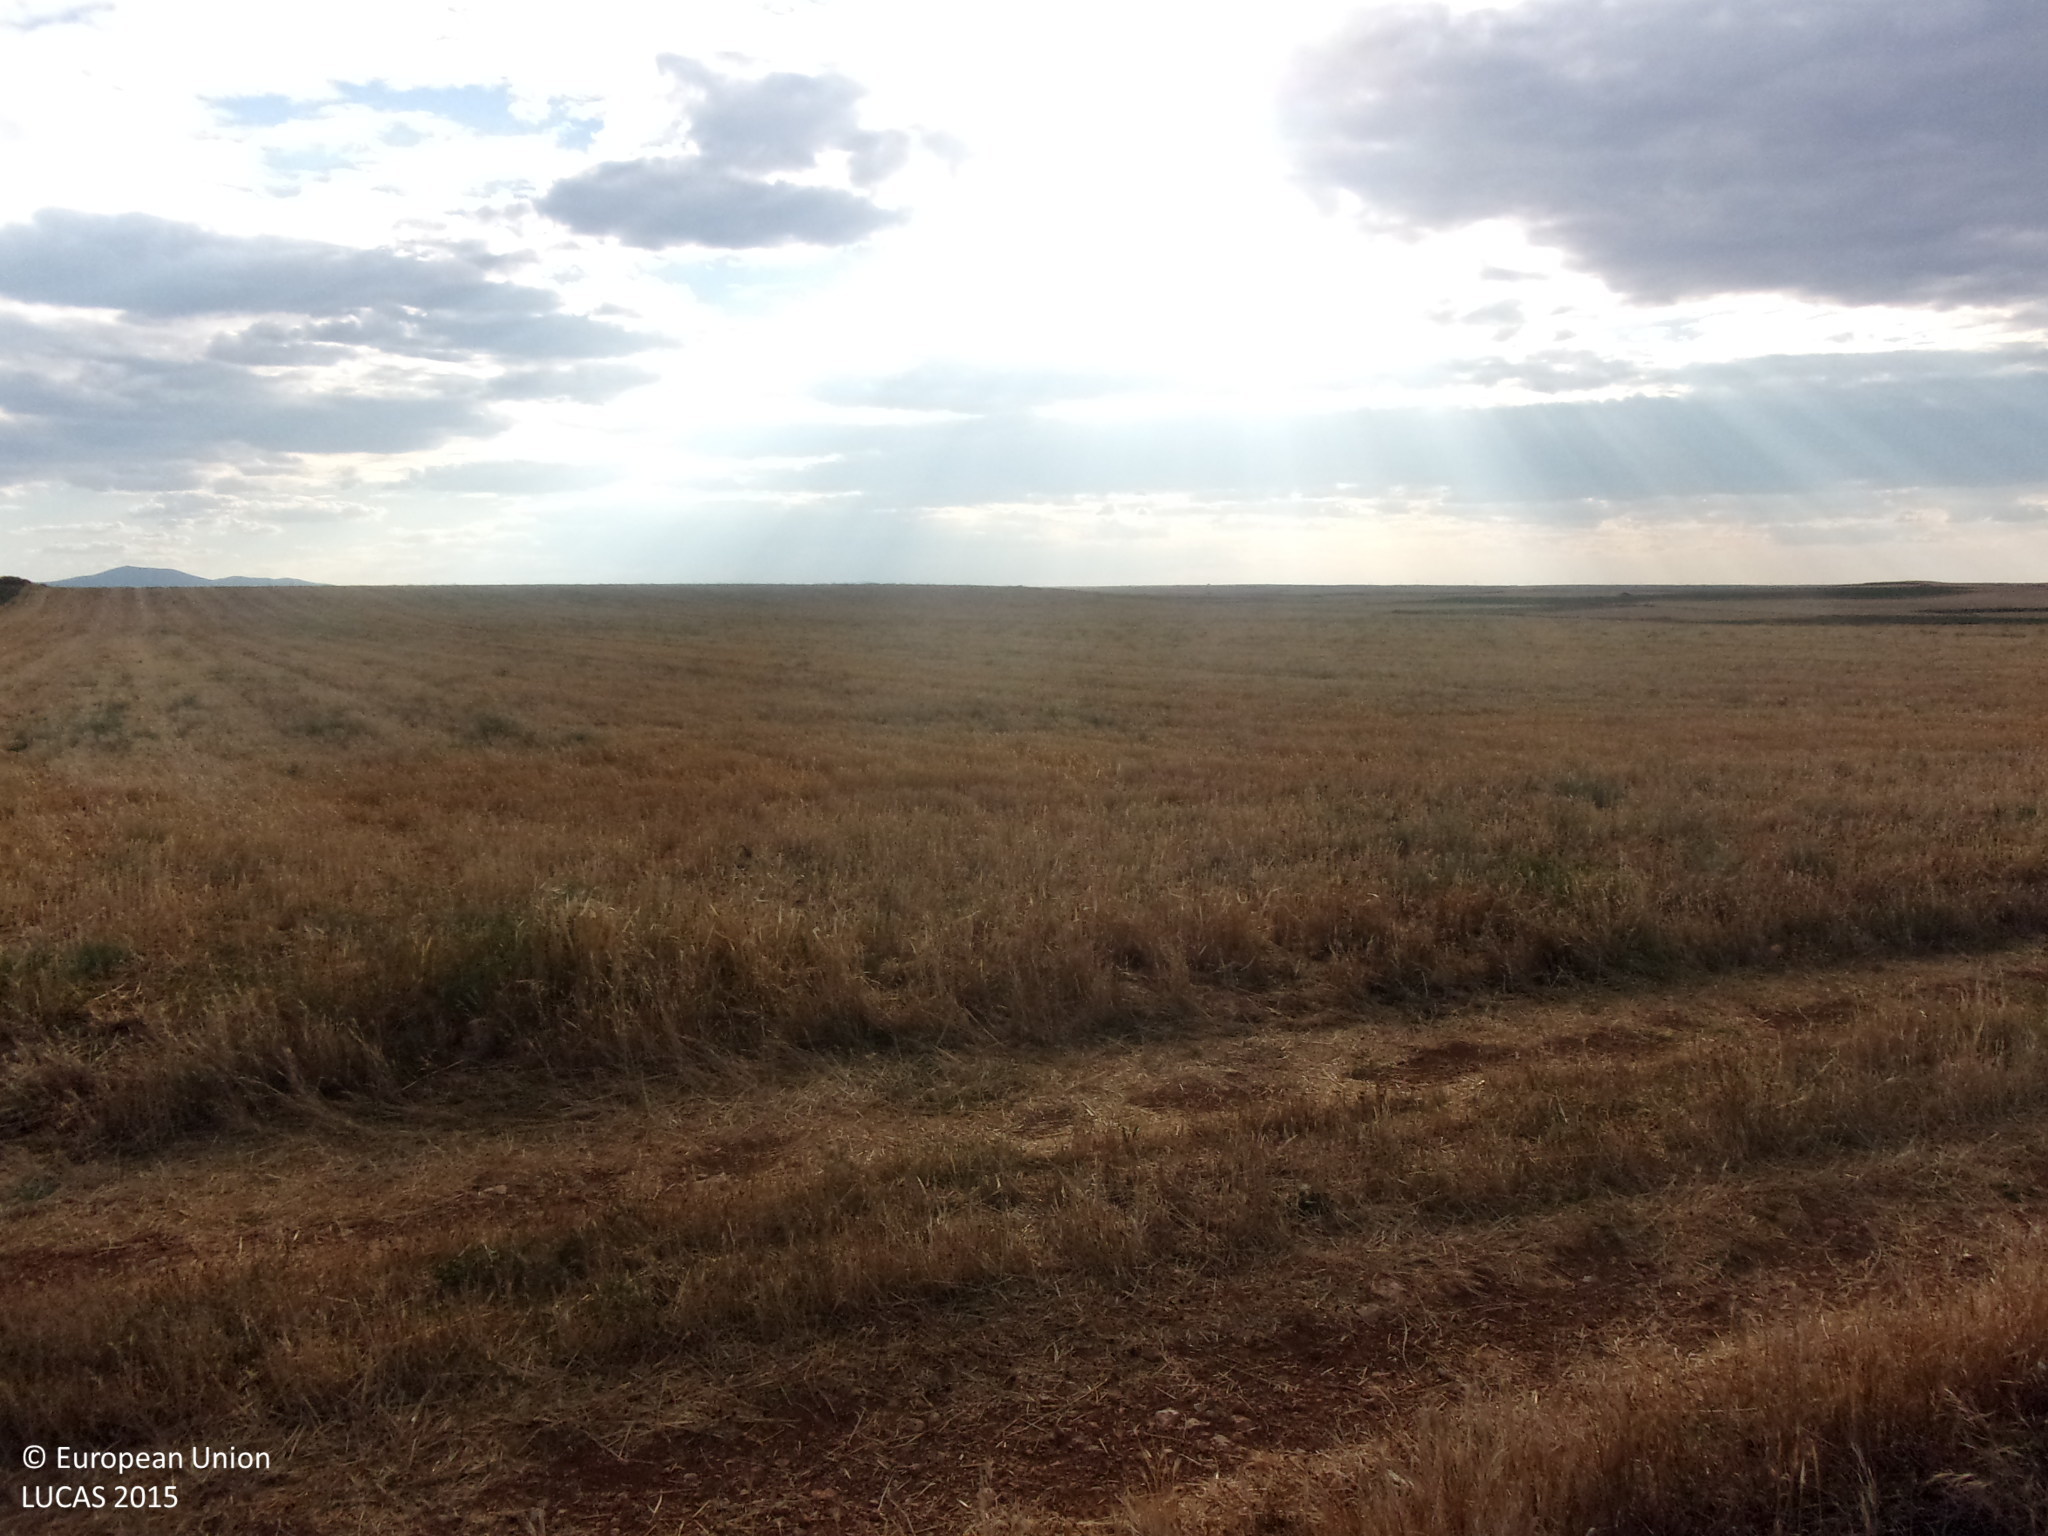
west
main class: Cropland
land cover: Barley
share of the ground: < 10 %
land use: Agriculture (excluding fallow land and kitchen gardens)
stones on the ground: < 10 %
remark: Harvested field
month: July
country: ES
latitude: 41.1720
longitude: -1.3805
